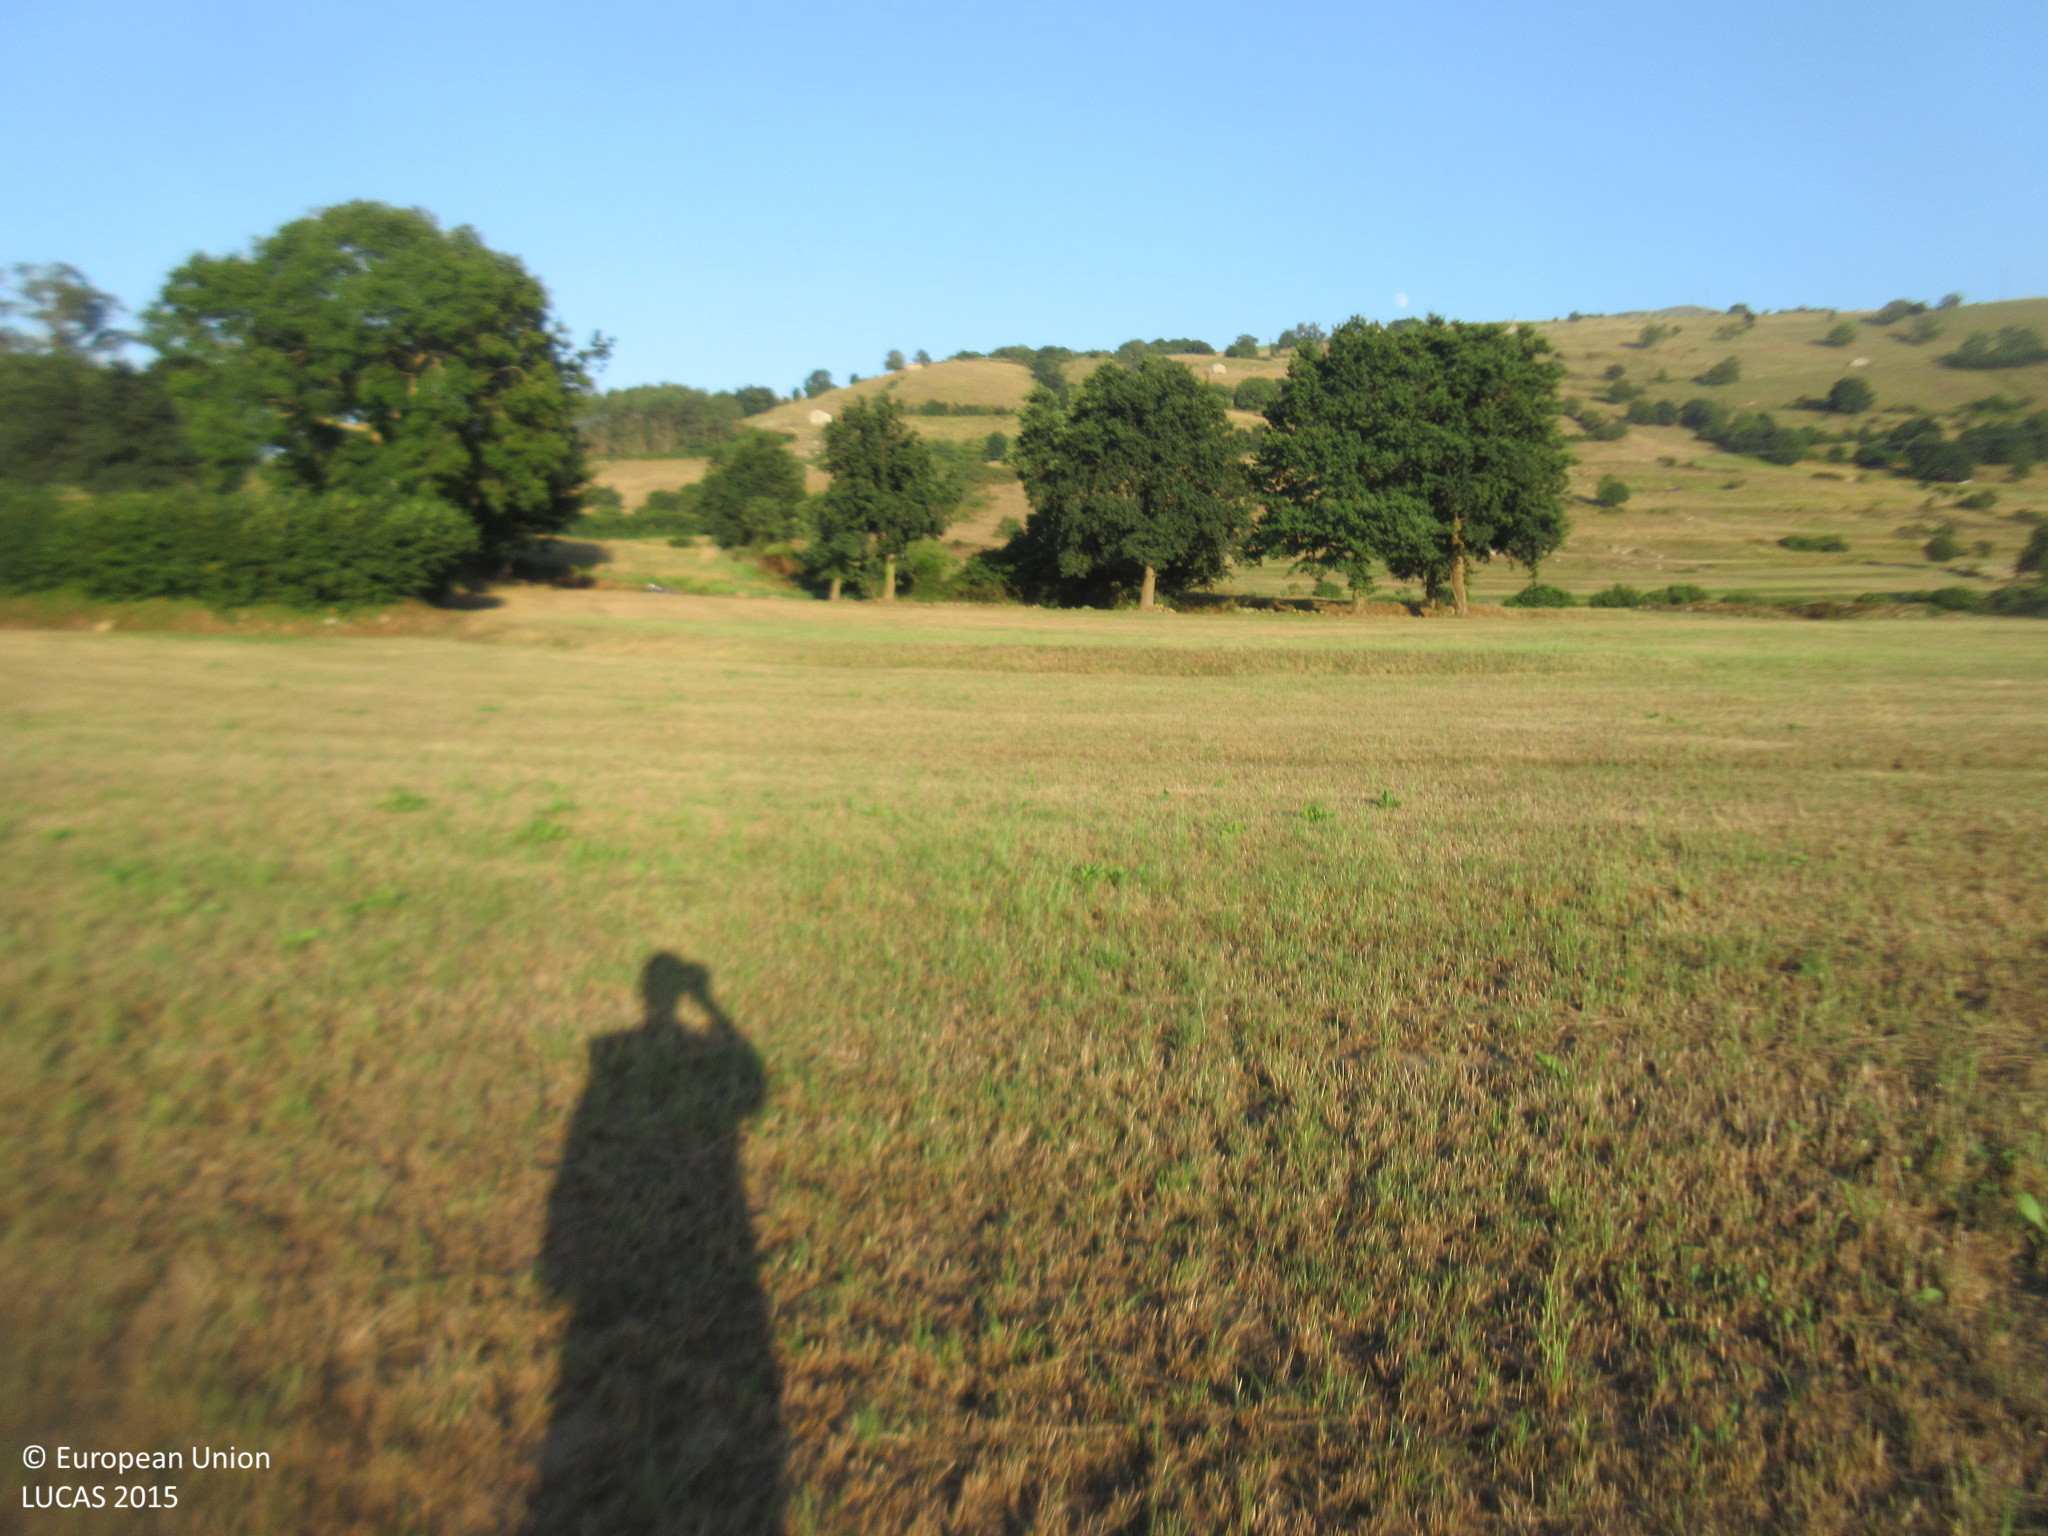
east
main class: Cropland
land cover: Temporary grasslands
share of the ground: > 75 %
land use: Agriculture (excluding fallow land and kitchen gardens)
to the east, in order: Temporary grasslands; Abandoned hedges; Maize; Grassland without tree/shrub cover; Groves; Tracks; Shrubland without tree cover; Groves; Grassland without tree/shrub cover; Dry stone walls; Grassland without tree/shrub cover
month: July
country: ES
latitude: 43.2591
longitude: -3.9324
